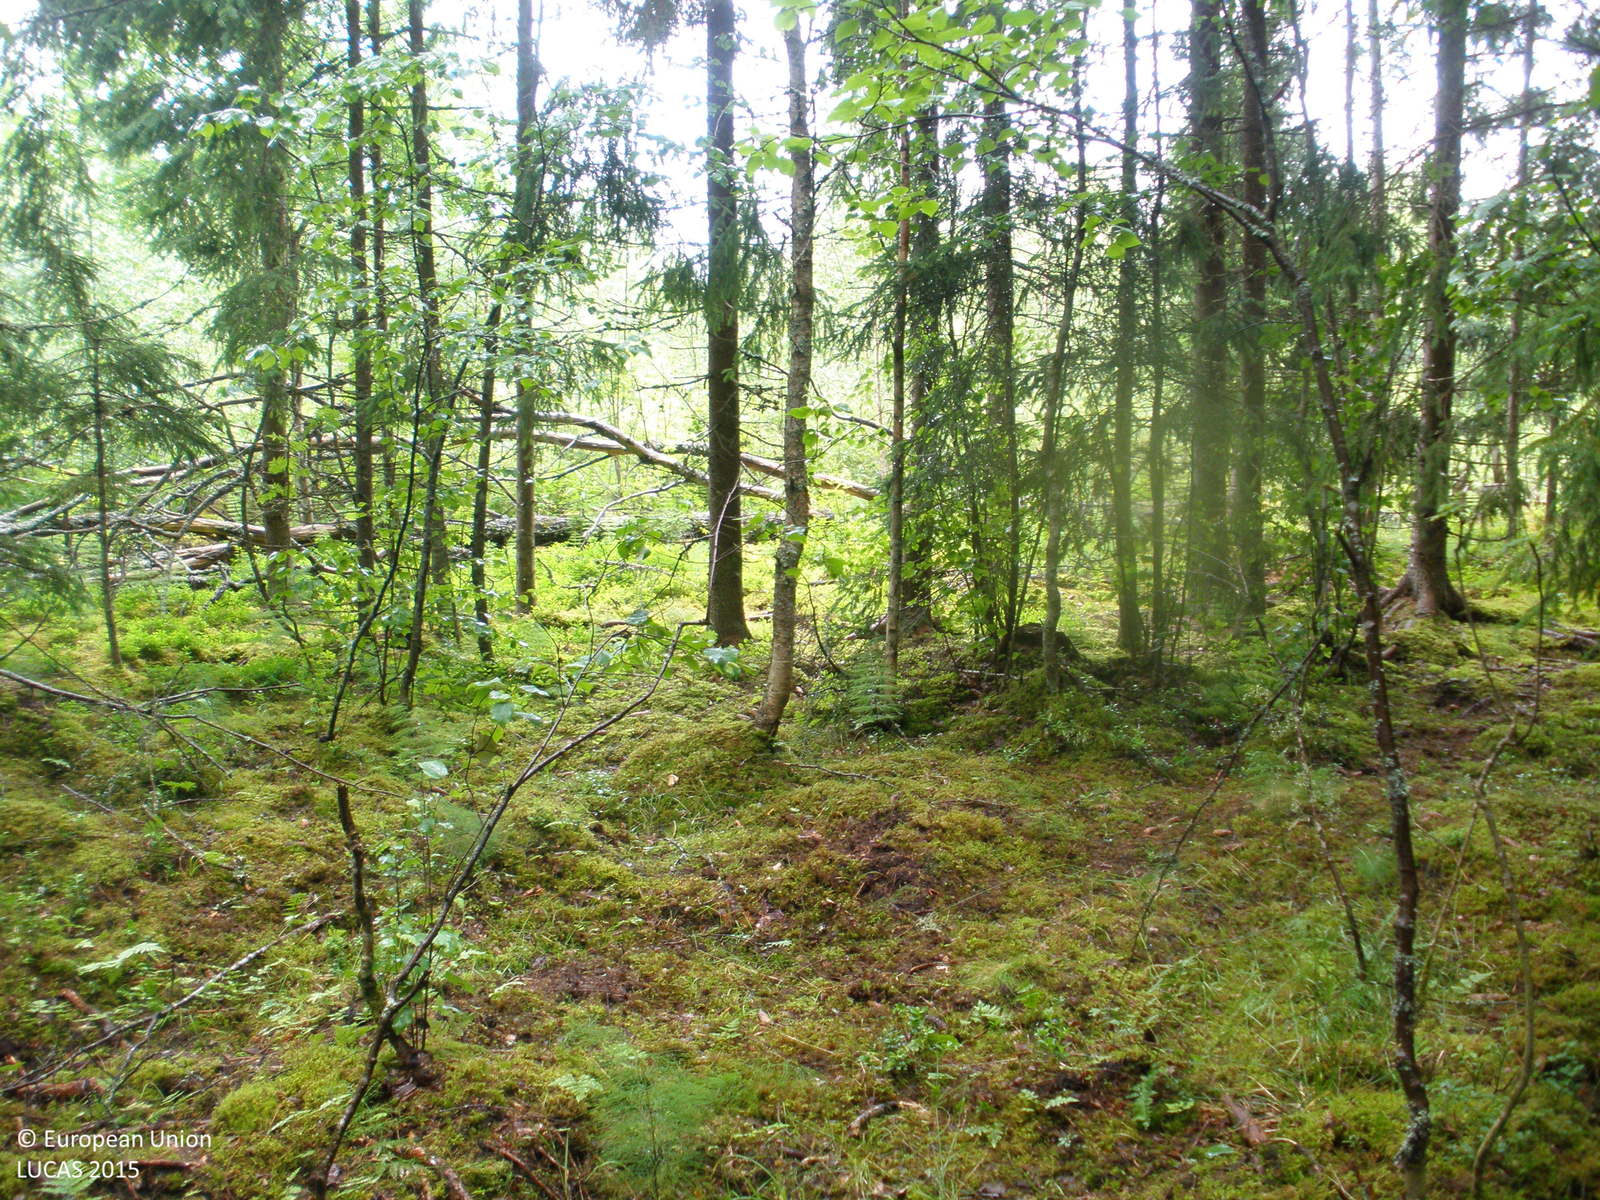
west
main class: Woodland
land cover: Spruce dominated coniferous woodland
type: boreal forest
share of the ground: > 75 %
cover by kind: coniferous forest trees 80 %, lichens and mosses 10 %, broadleaved forest trees 5 %, herbaceous plants 5 %
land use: Forestry
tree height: > 5 m
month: July
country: FI
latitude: 61.2794
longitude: 23.7598
